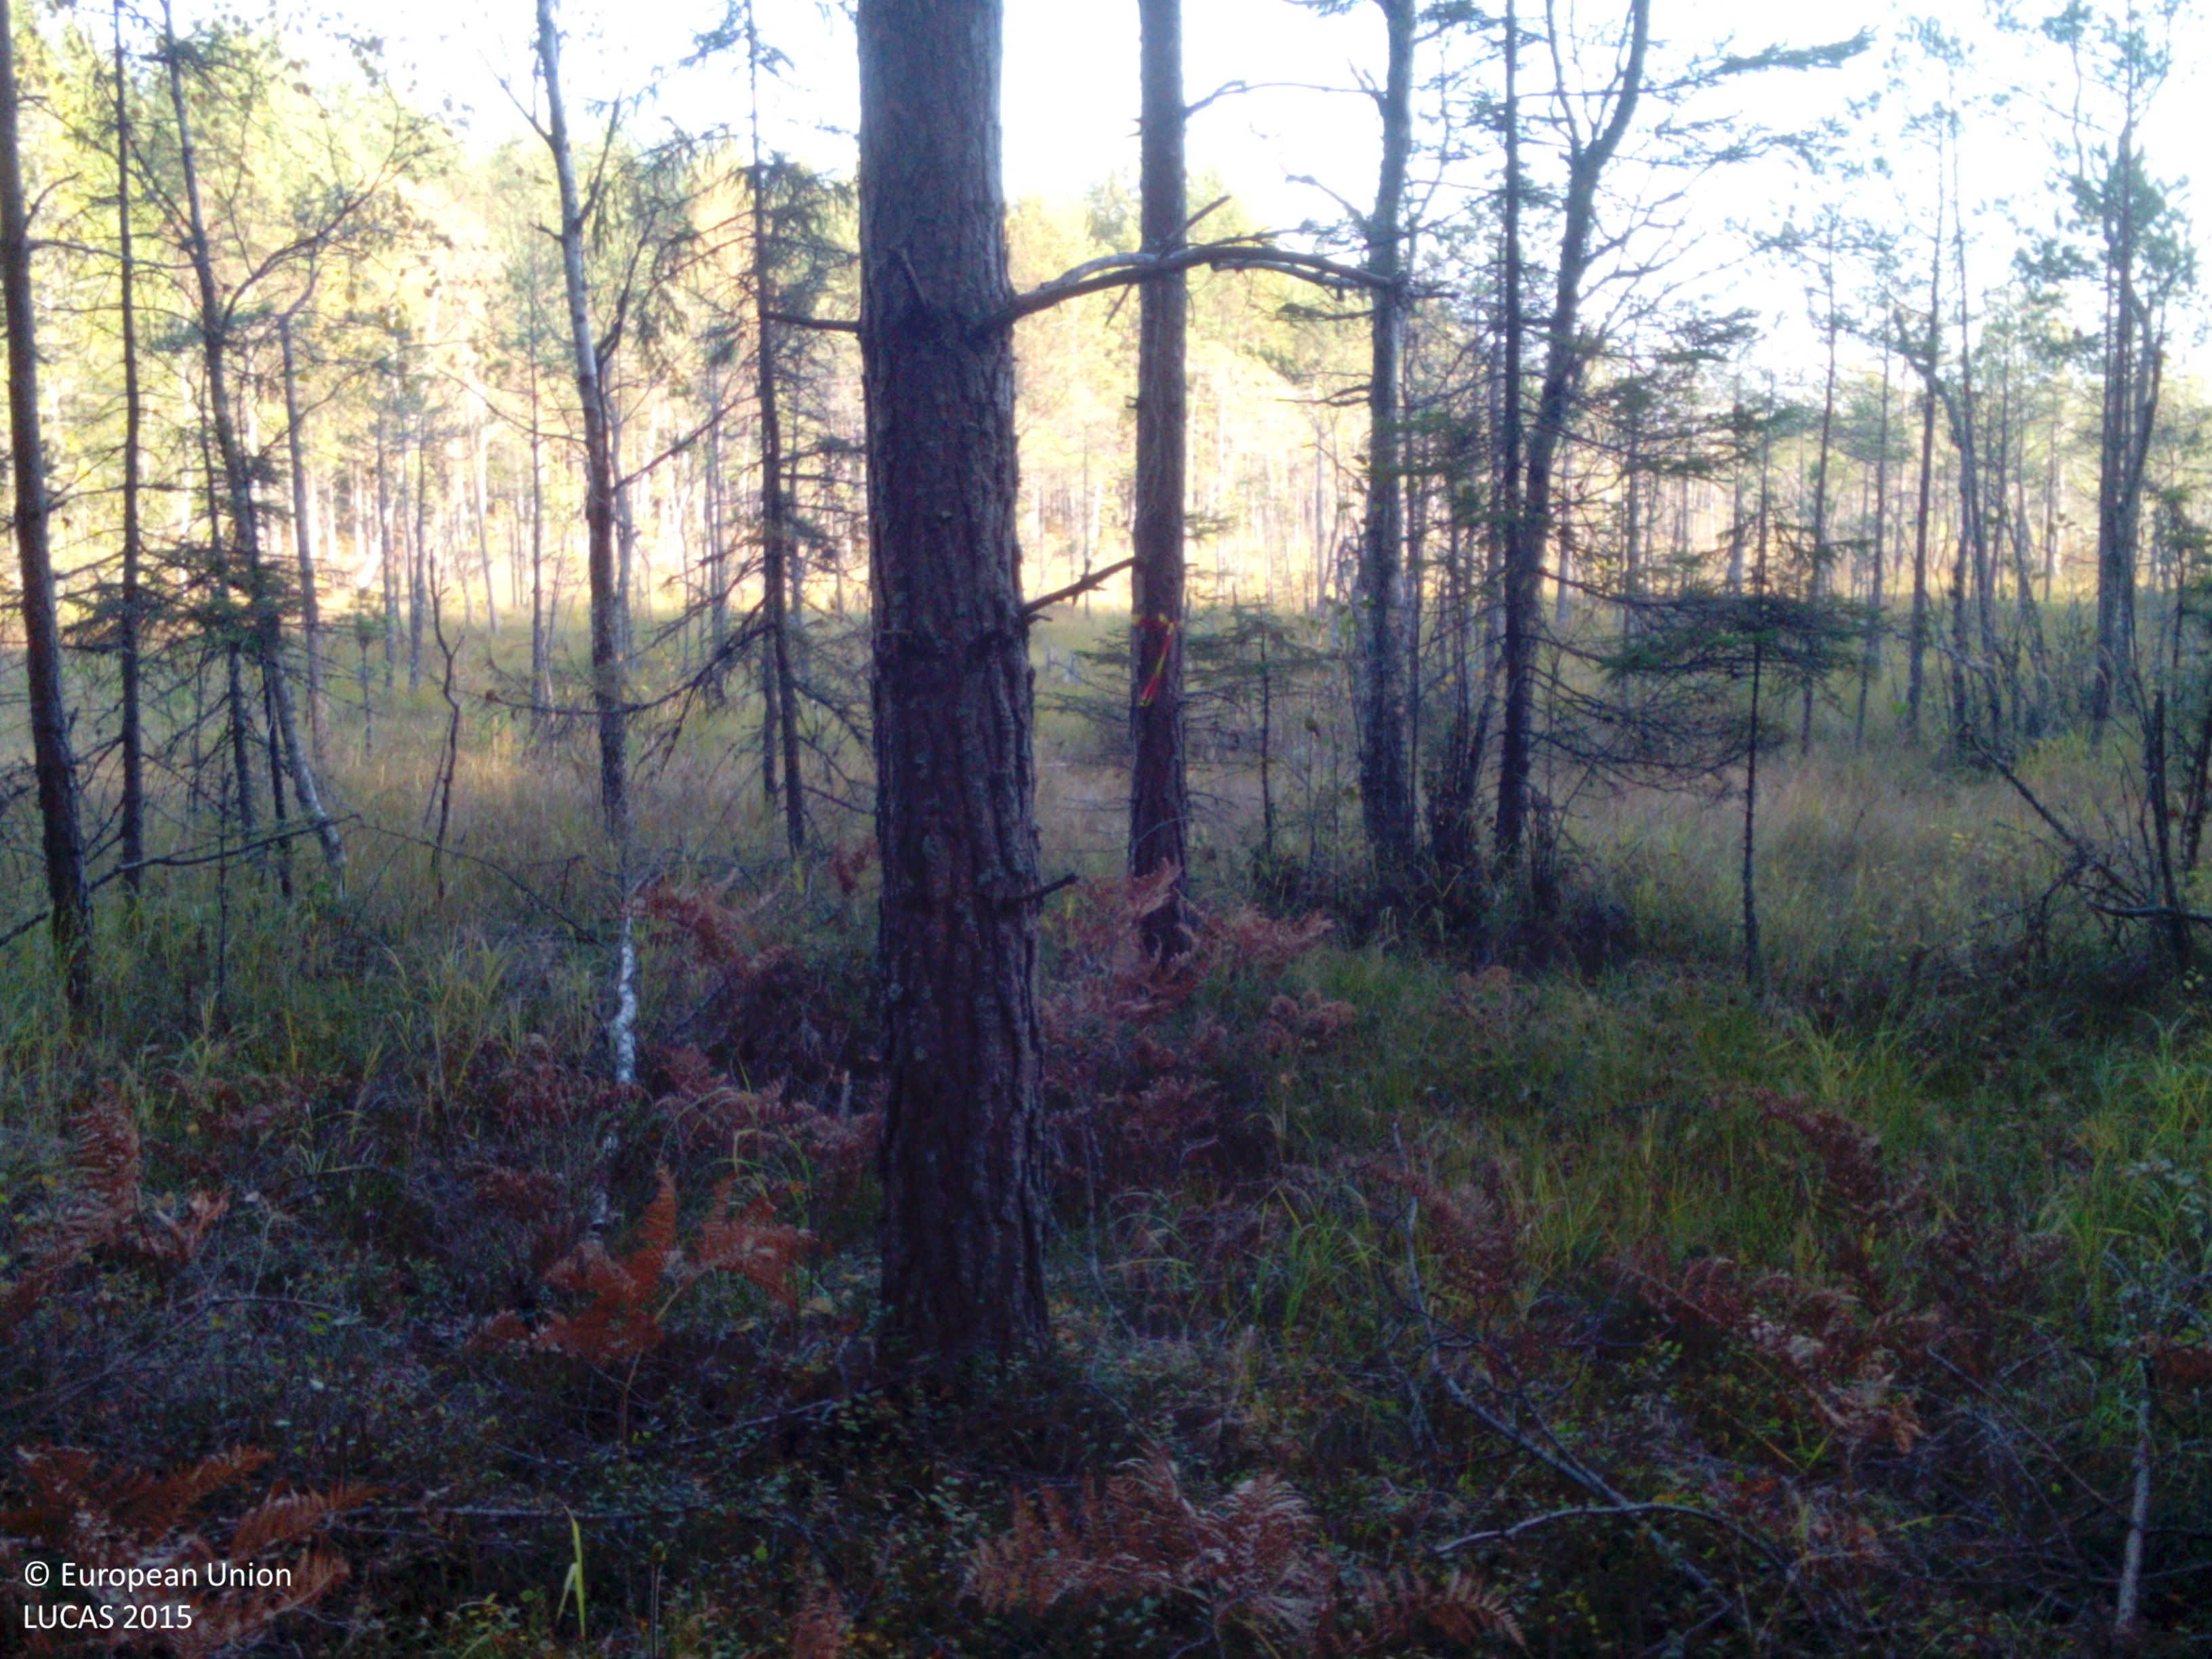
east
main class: Woodland
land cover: Pine dominated coniferous woodland
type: boreal forest
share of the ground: > 75 %
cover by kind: coniferous forest trees 85 %, herbaceous plants 10 %, lichens and mosses 5 %
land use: Forestry
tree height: > 5 m
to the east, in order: Pine dominated coniferous woodland; Inland marshes; Pine dominated coniferous woodland; Peatbogs
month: October
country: SE
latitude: 58.8650
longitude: 16.3234
